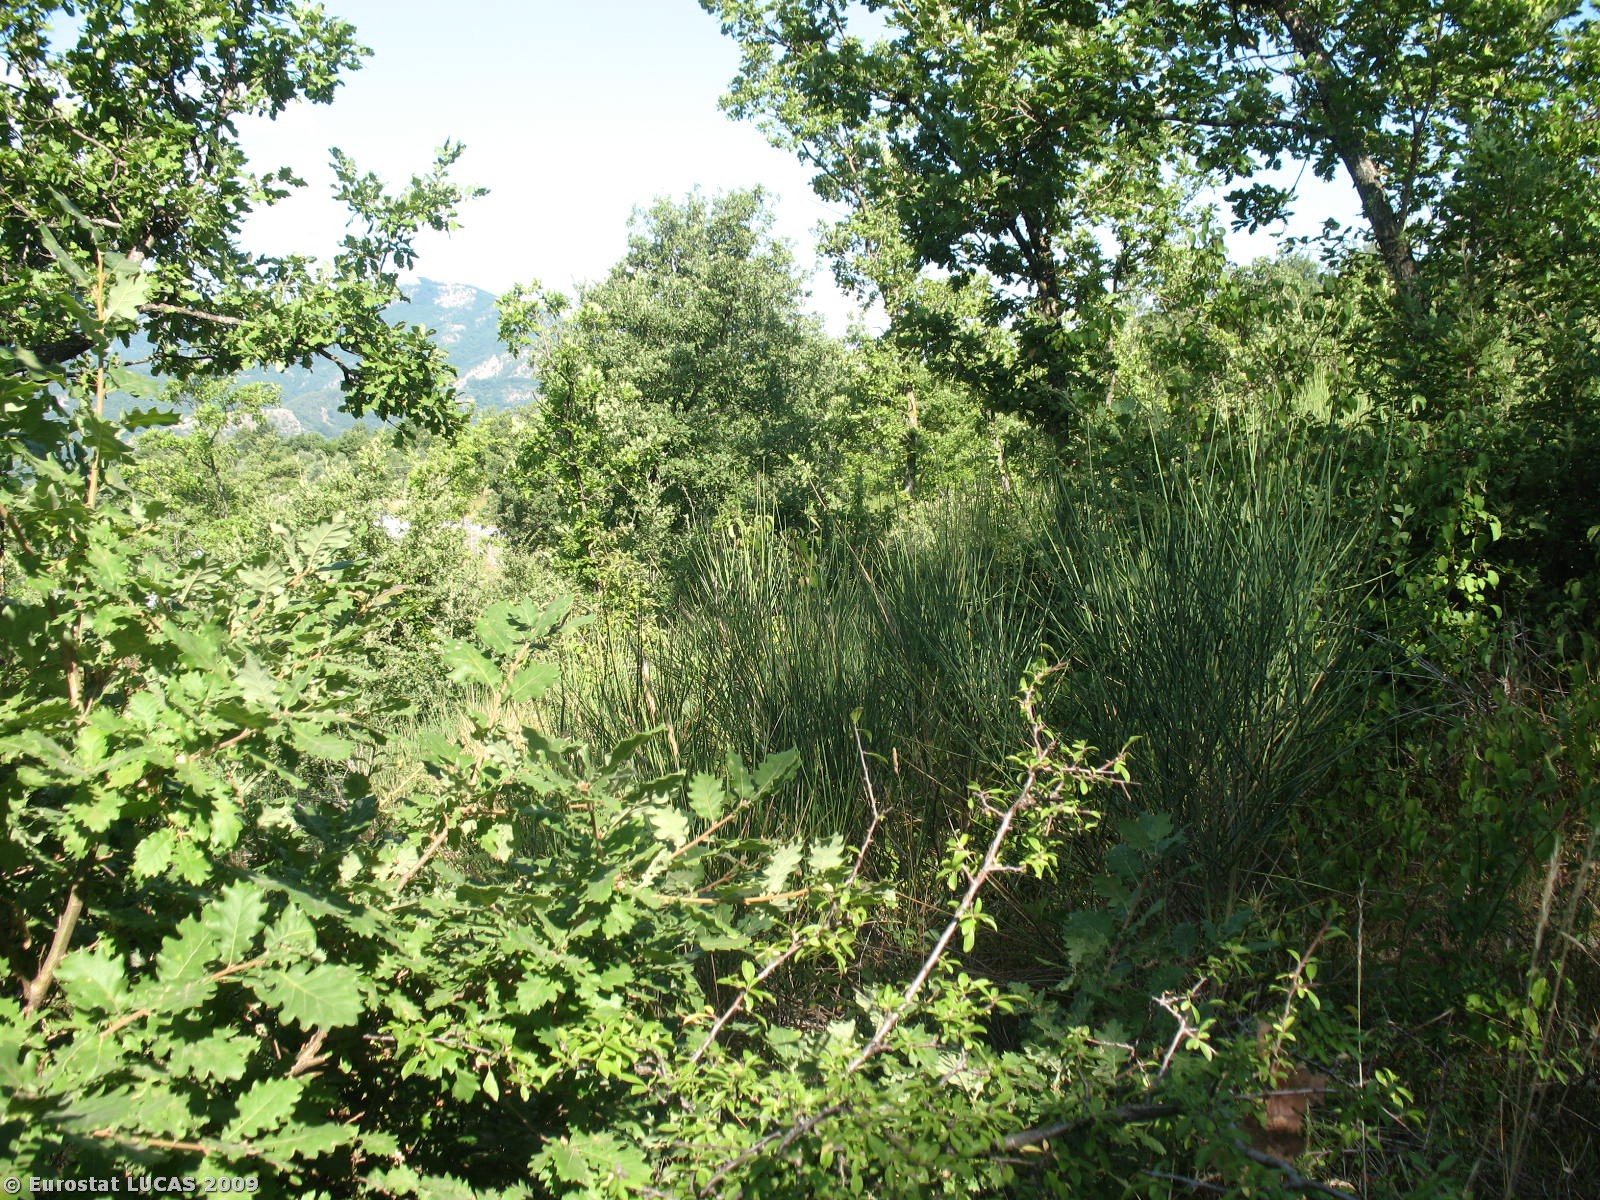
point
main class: Woodland
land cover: Broadleaved woodland
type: mesophytic deciduous forest
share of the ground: > 75 %
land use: Agriculture (excluding fallow land and kitchen gardens)
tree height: > 5 m
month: July
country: IT
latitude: 40.8613
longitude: 15.0696
